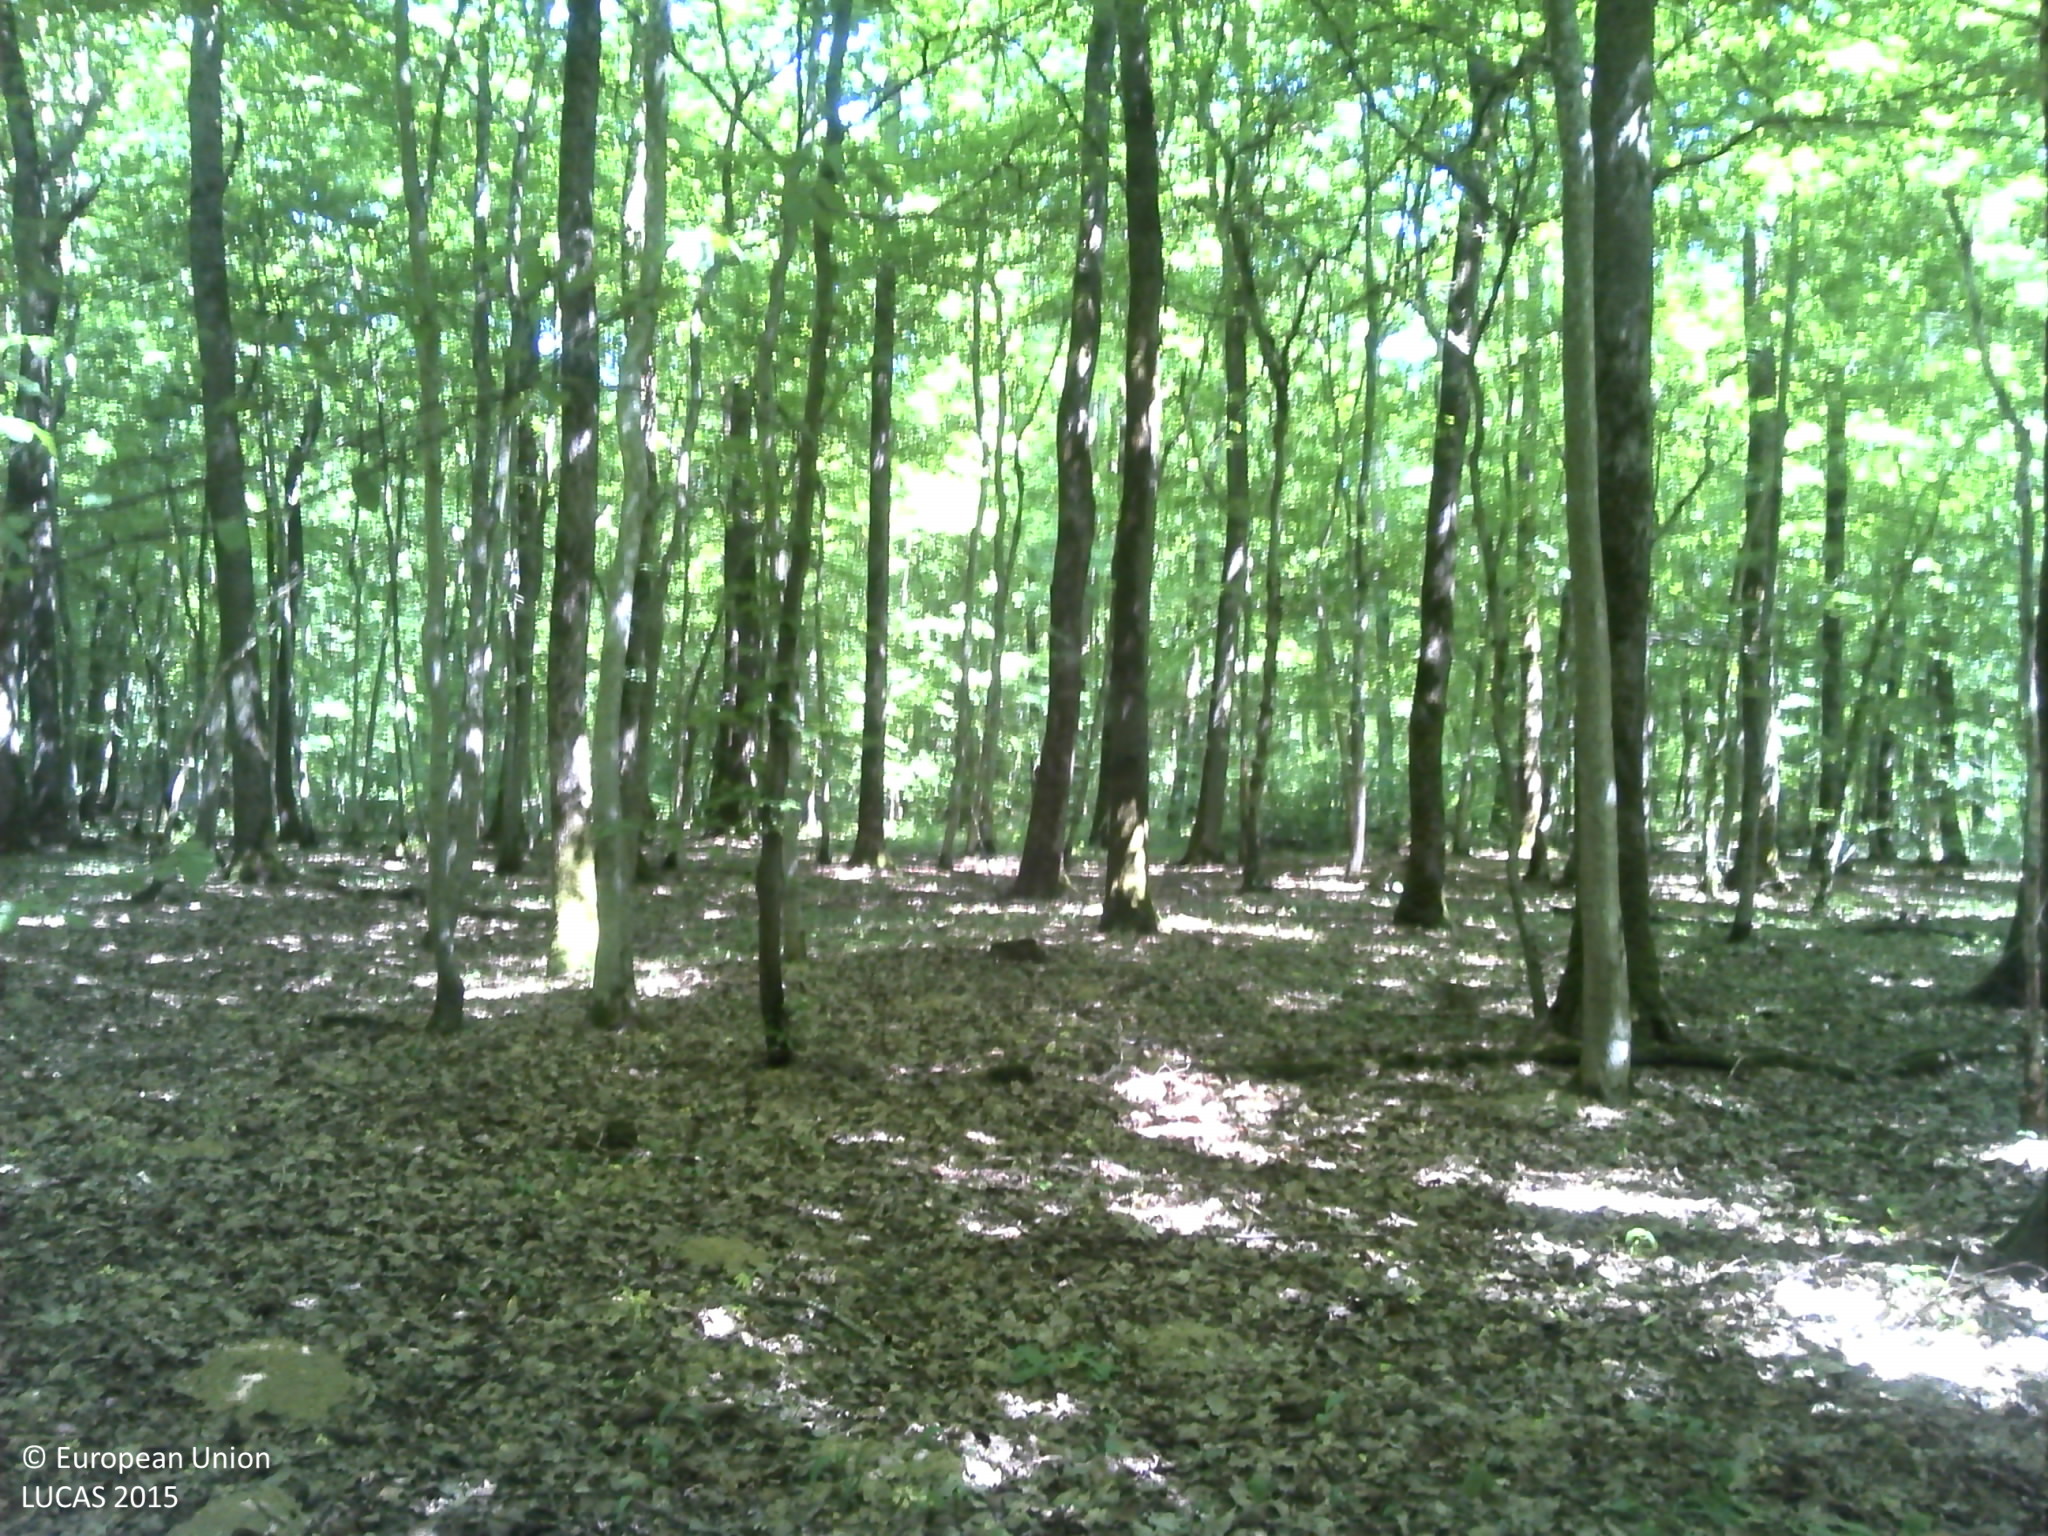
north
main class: Woodland
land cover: Broadleaved woodland
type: mesophytic deciduous forest
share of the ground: > 75 %
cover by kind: broadleaved forest trees 100 %
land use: Forestry
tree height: > 5 m
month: July
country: FR
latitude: 49.4711
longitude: 6.1494
